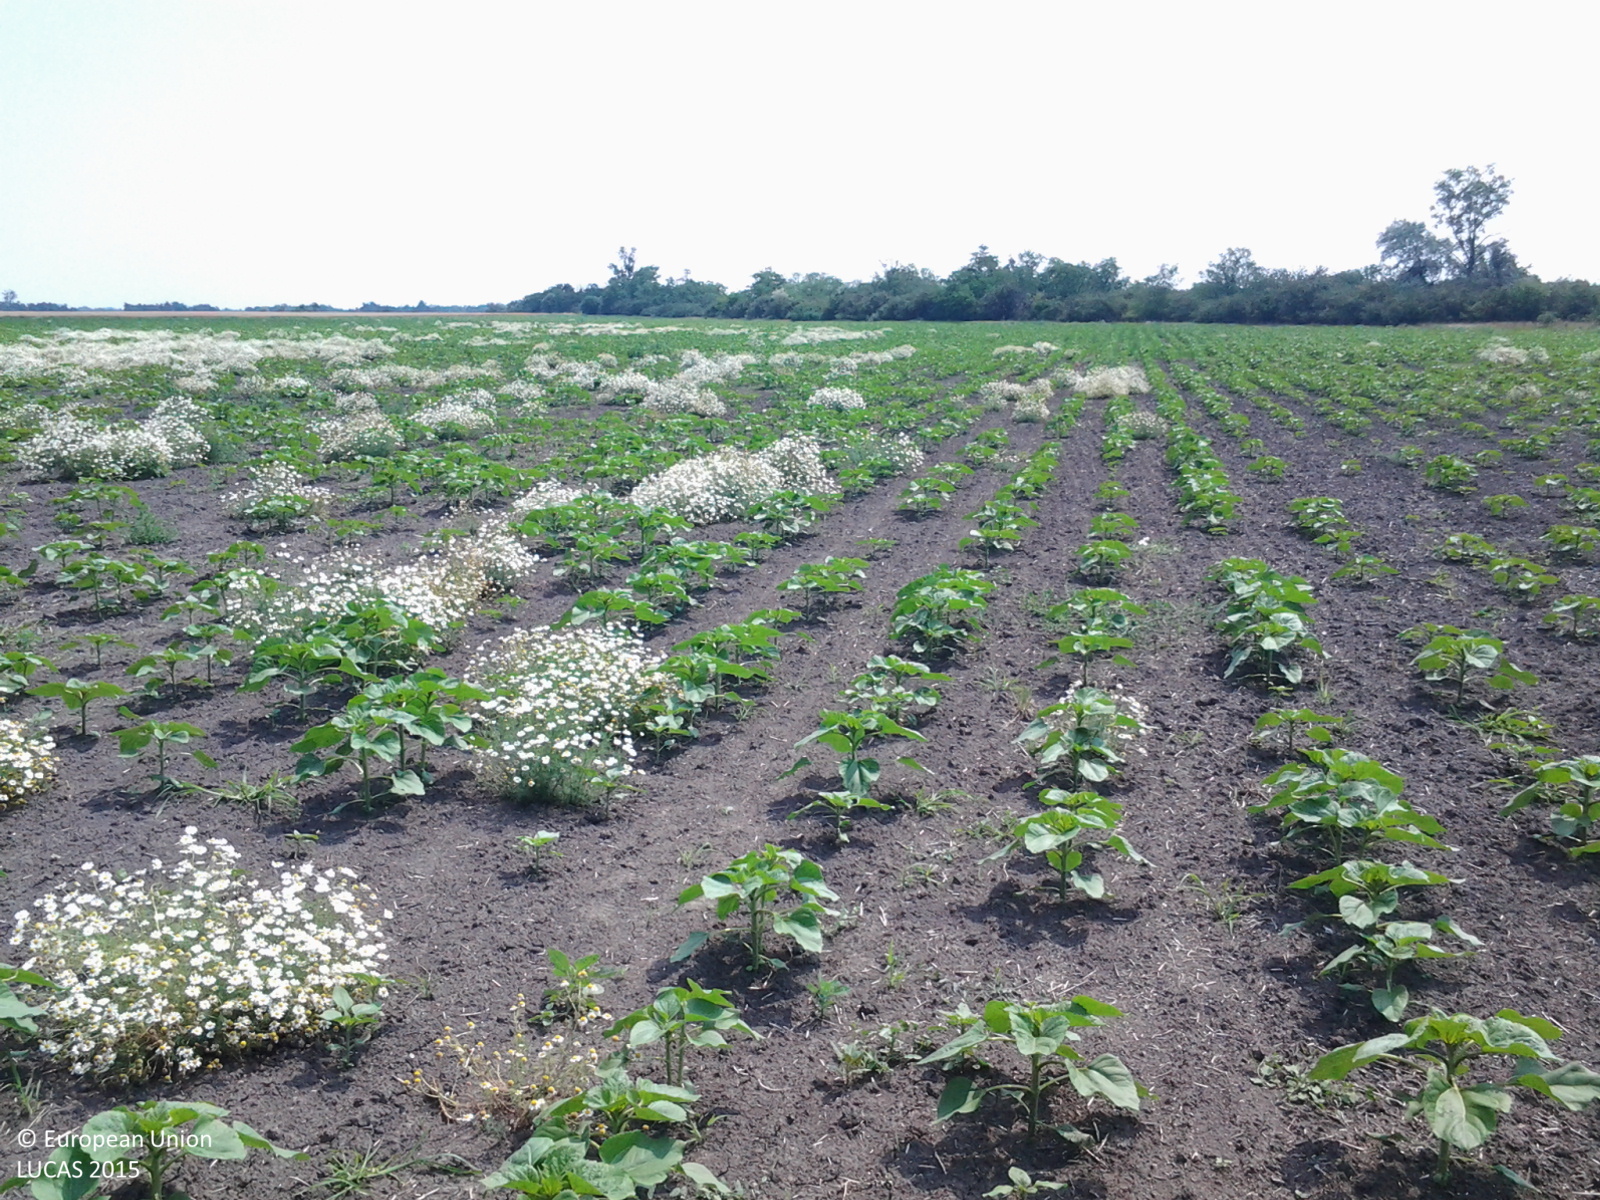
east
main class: Cropland
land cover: Sunflower
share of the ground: 25 - 50 %
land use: Agriculture (excluding fallow land and kitchen gardens)
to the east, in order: Sunflower; Grass margins; Broadleaved woodland
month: July
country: HU
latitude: 46.9761
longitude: 20.5056
